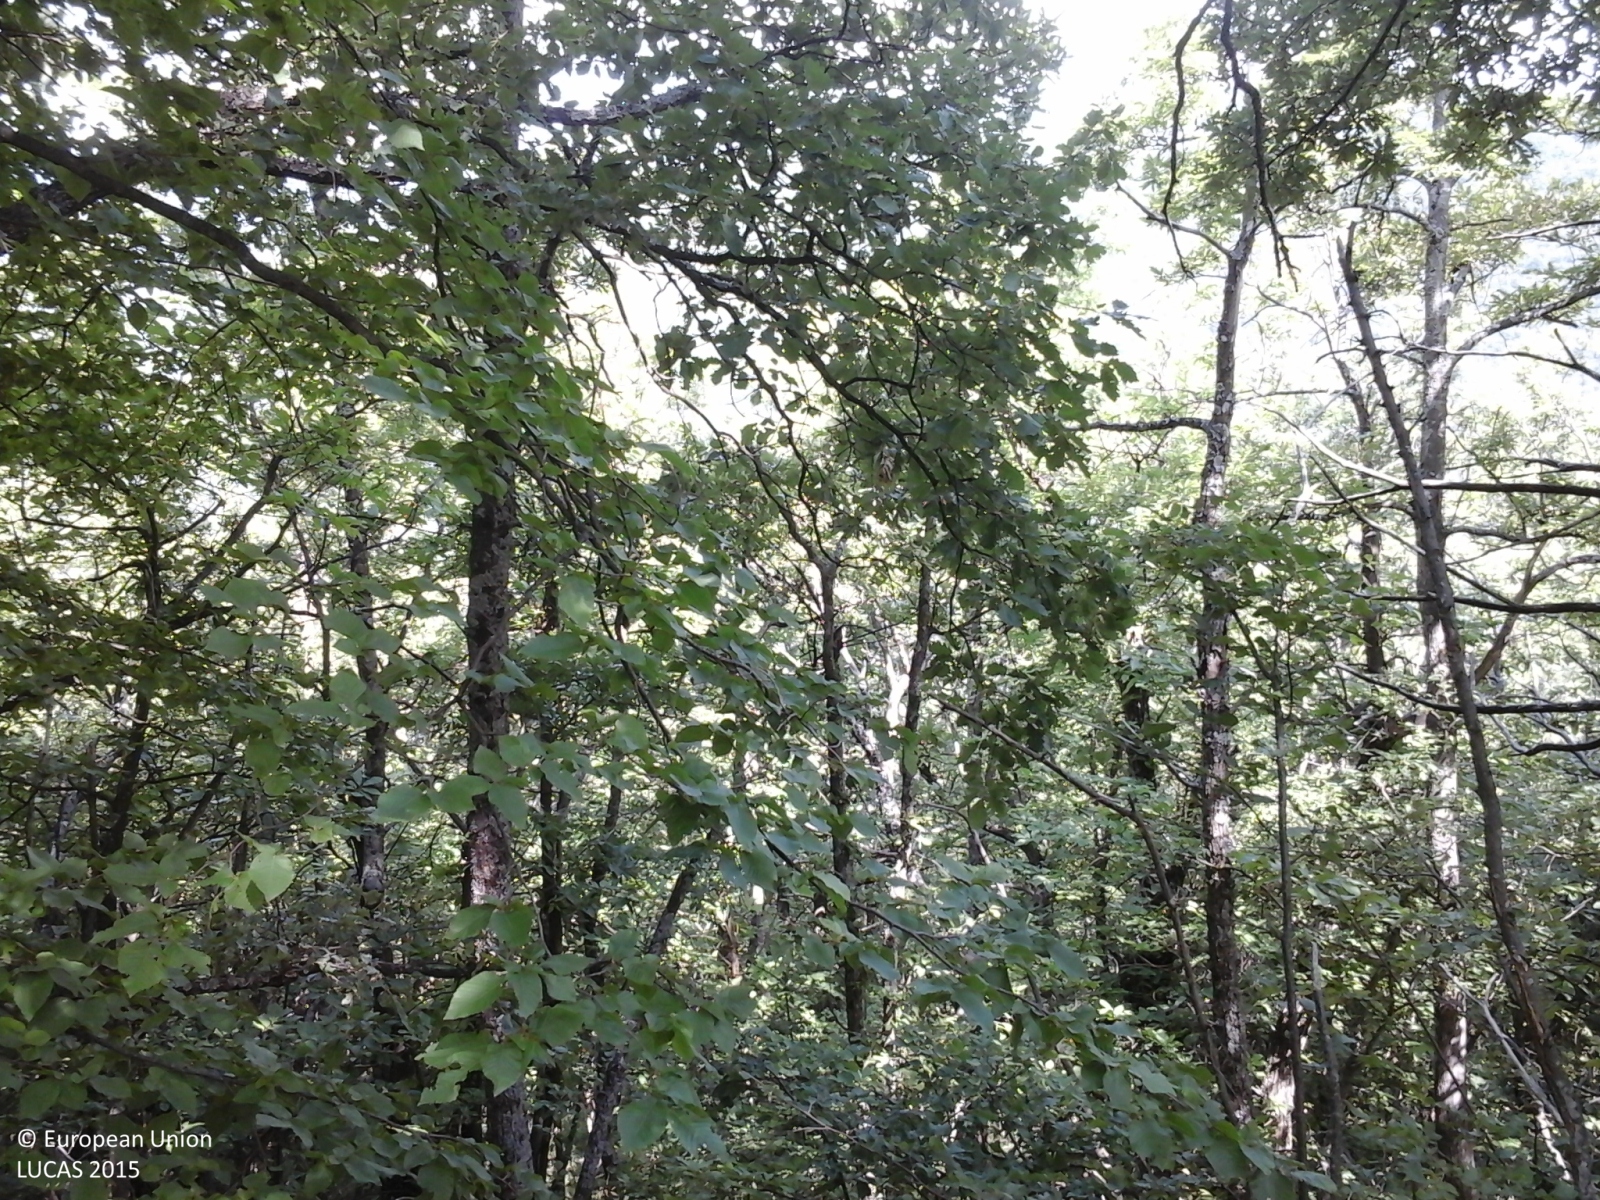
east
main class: Woodland
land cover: Broadleaved woodland
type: thermophilous deciduous forest
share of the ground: > 75 %
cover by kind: broadleaved forest trees 100 %
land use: Forestry
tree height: > 5 m
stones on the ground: 25 - 50 %
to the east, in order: Broadleaved woodland; Tracks; Broadleaved woodland
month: June
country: IT
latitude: 44.6533
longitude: 9.1066
